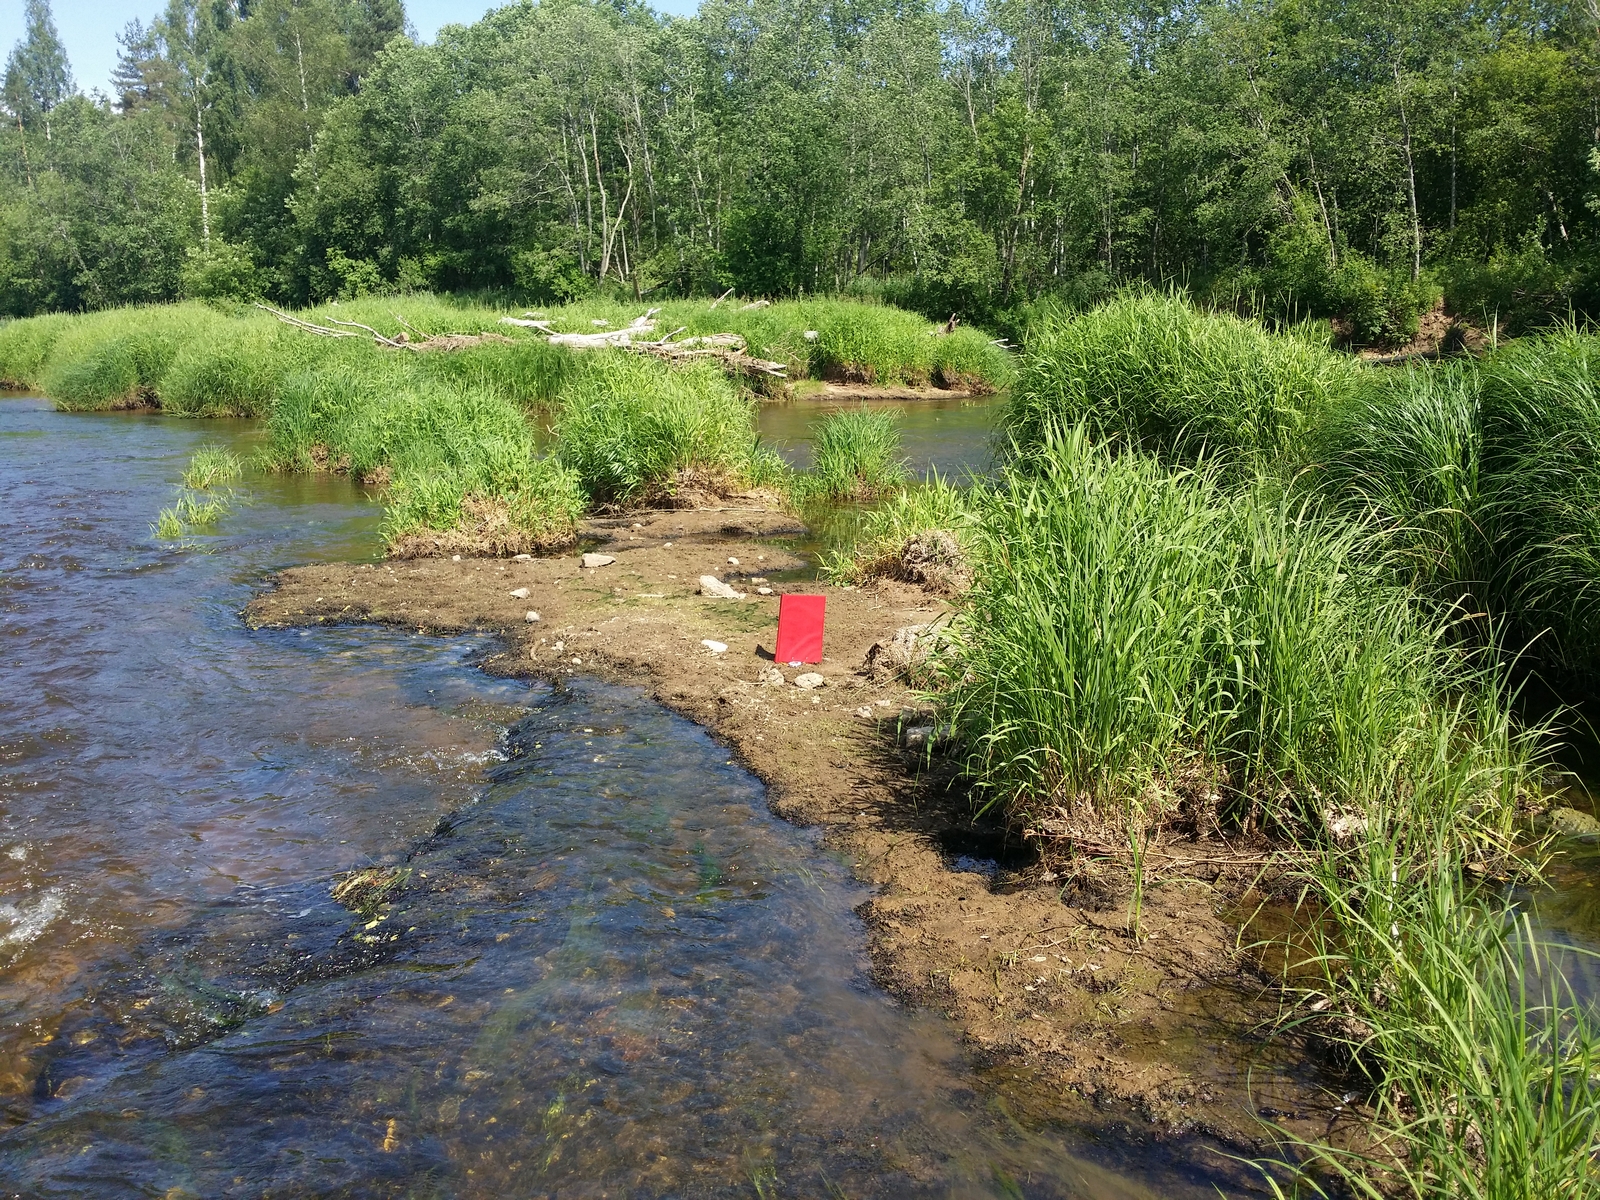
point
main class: Grassland
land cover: Spontaneously vegetated surfaces
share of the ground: 50 - 75 %
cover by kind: herbaceous plants 60 %, unconsolidated bare surface 40 %
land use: Semi-natural and natural areas not in use
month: June
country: LV
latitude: 57.3955
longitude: 26.4657
